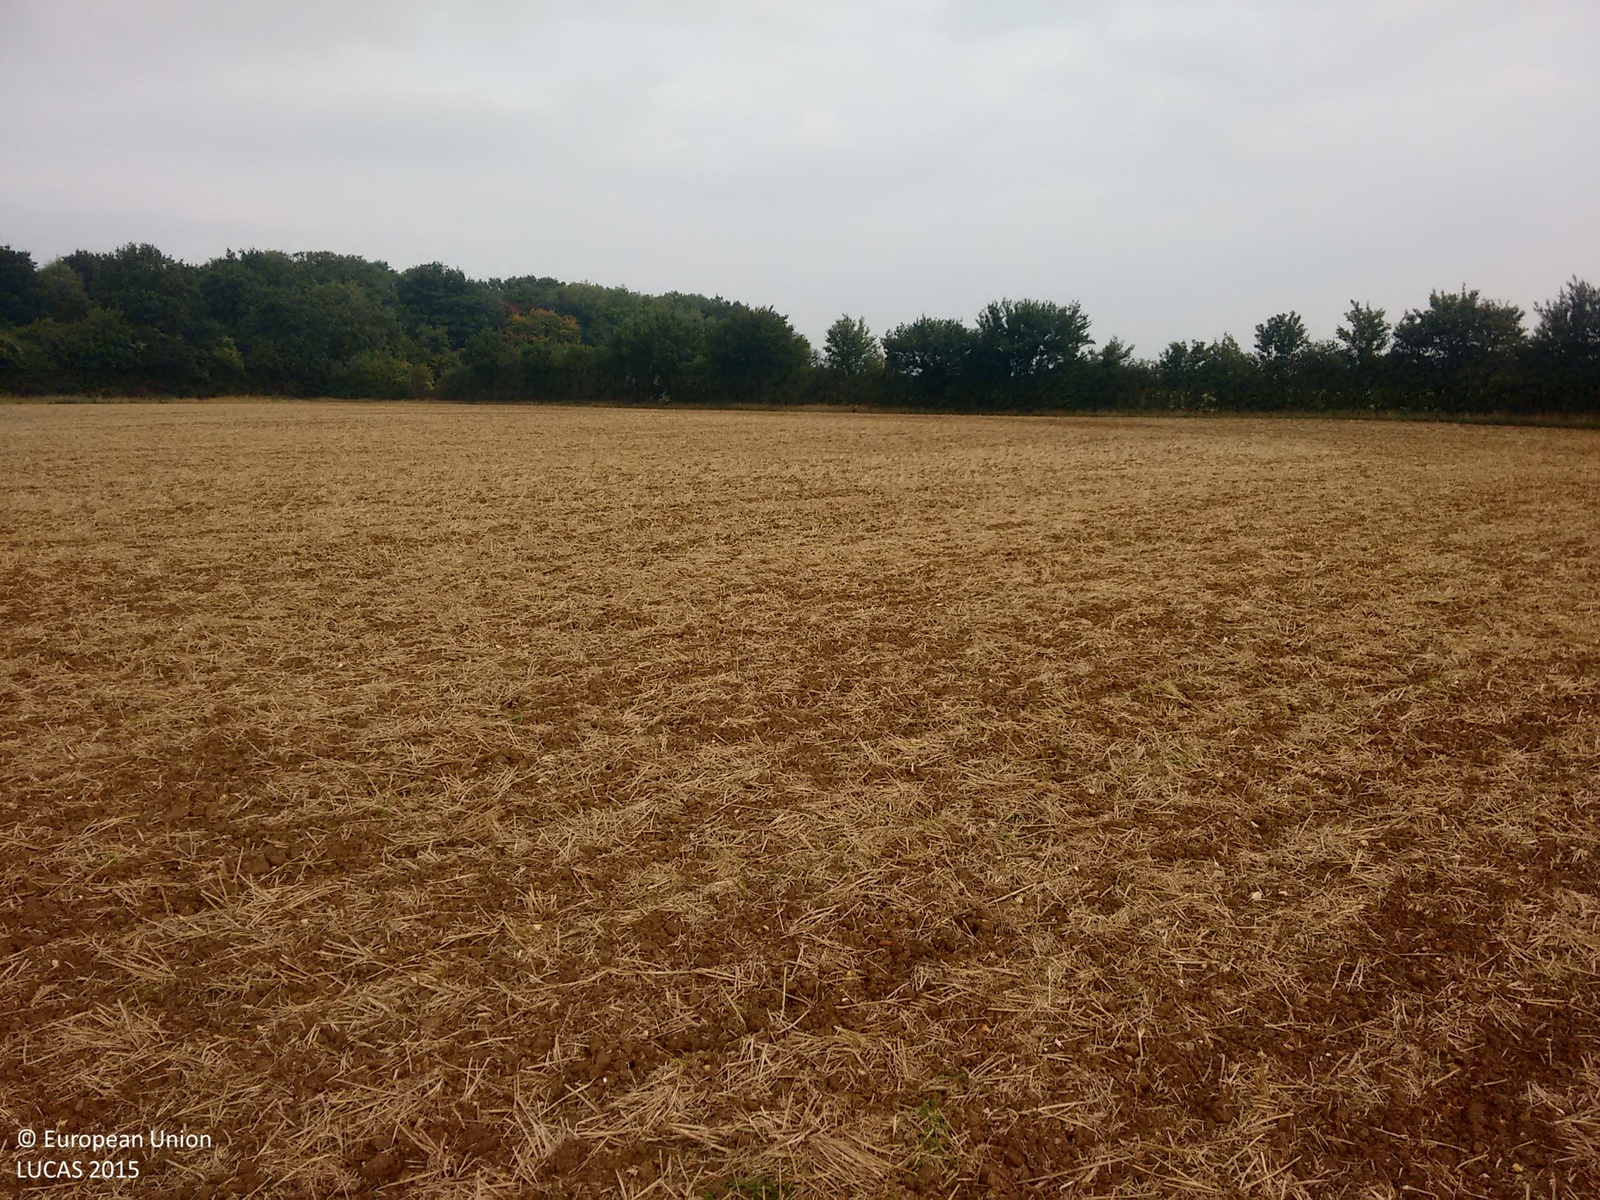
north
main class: Cropland
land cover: Oats
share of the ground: 25 - 50 %
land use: Agriculture (excluding fallow land and kitchen gardens)
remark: Harvested field
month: September
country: GB
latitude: 51.9049
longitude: 0.2752
